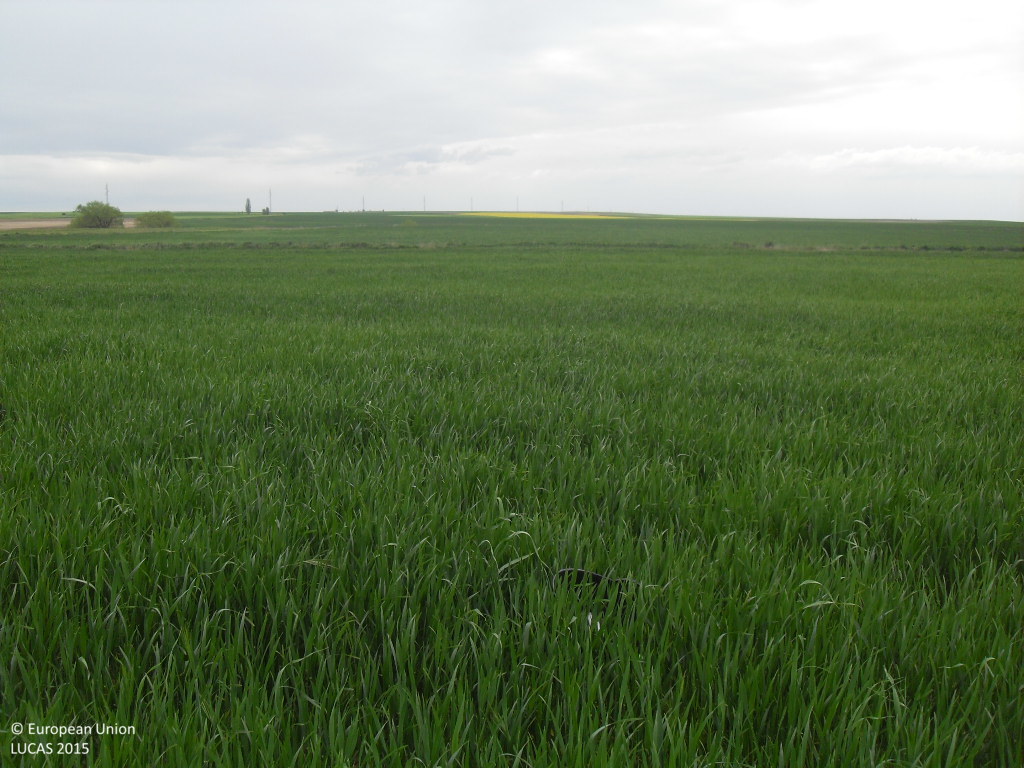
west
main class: Cropland
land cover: Common wheat
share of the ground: > 75 %
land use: Agriculture (excluding fallow land and kitchen gardens)
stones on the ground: < 10 %
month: April
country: ES
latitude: 40.9183
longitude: -5.1587
